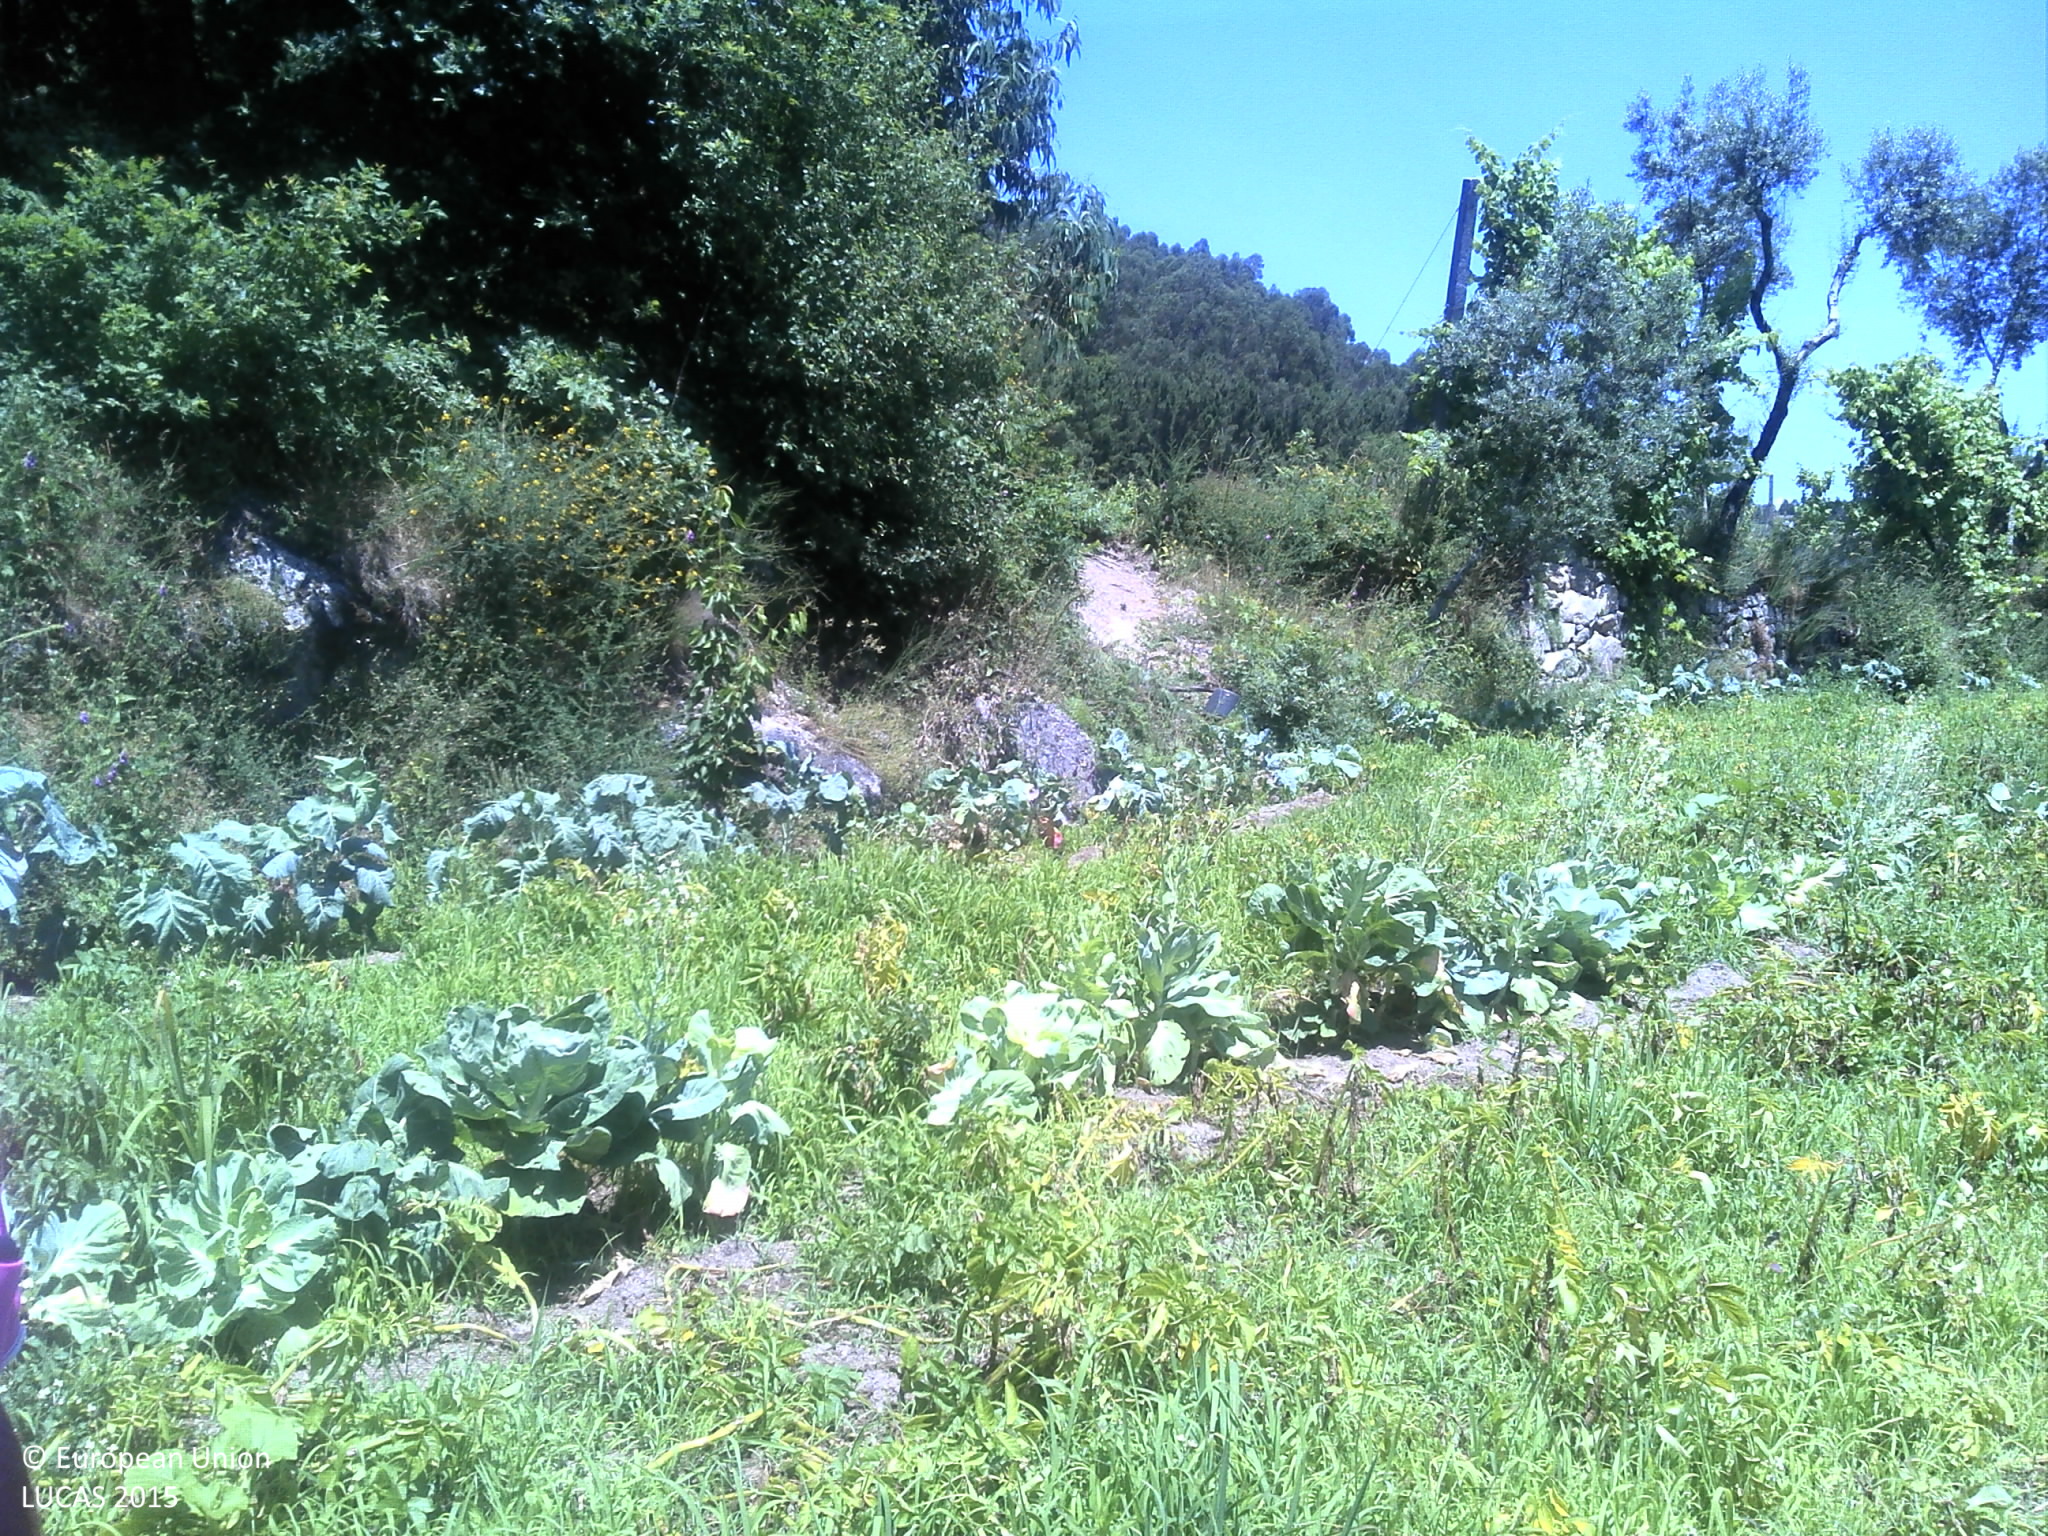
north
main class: Cropland
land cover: Other fresh vegetables
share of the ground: > 75 %
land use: Kitchen garden
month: June
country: PT
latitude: 41.5536
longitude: -8.3393
